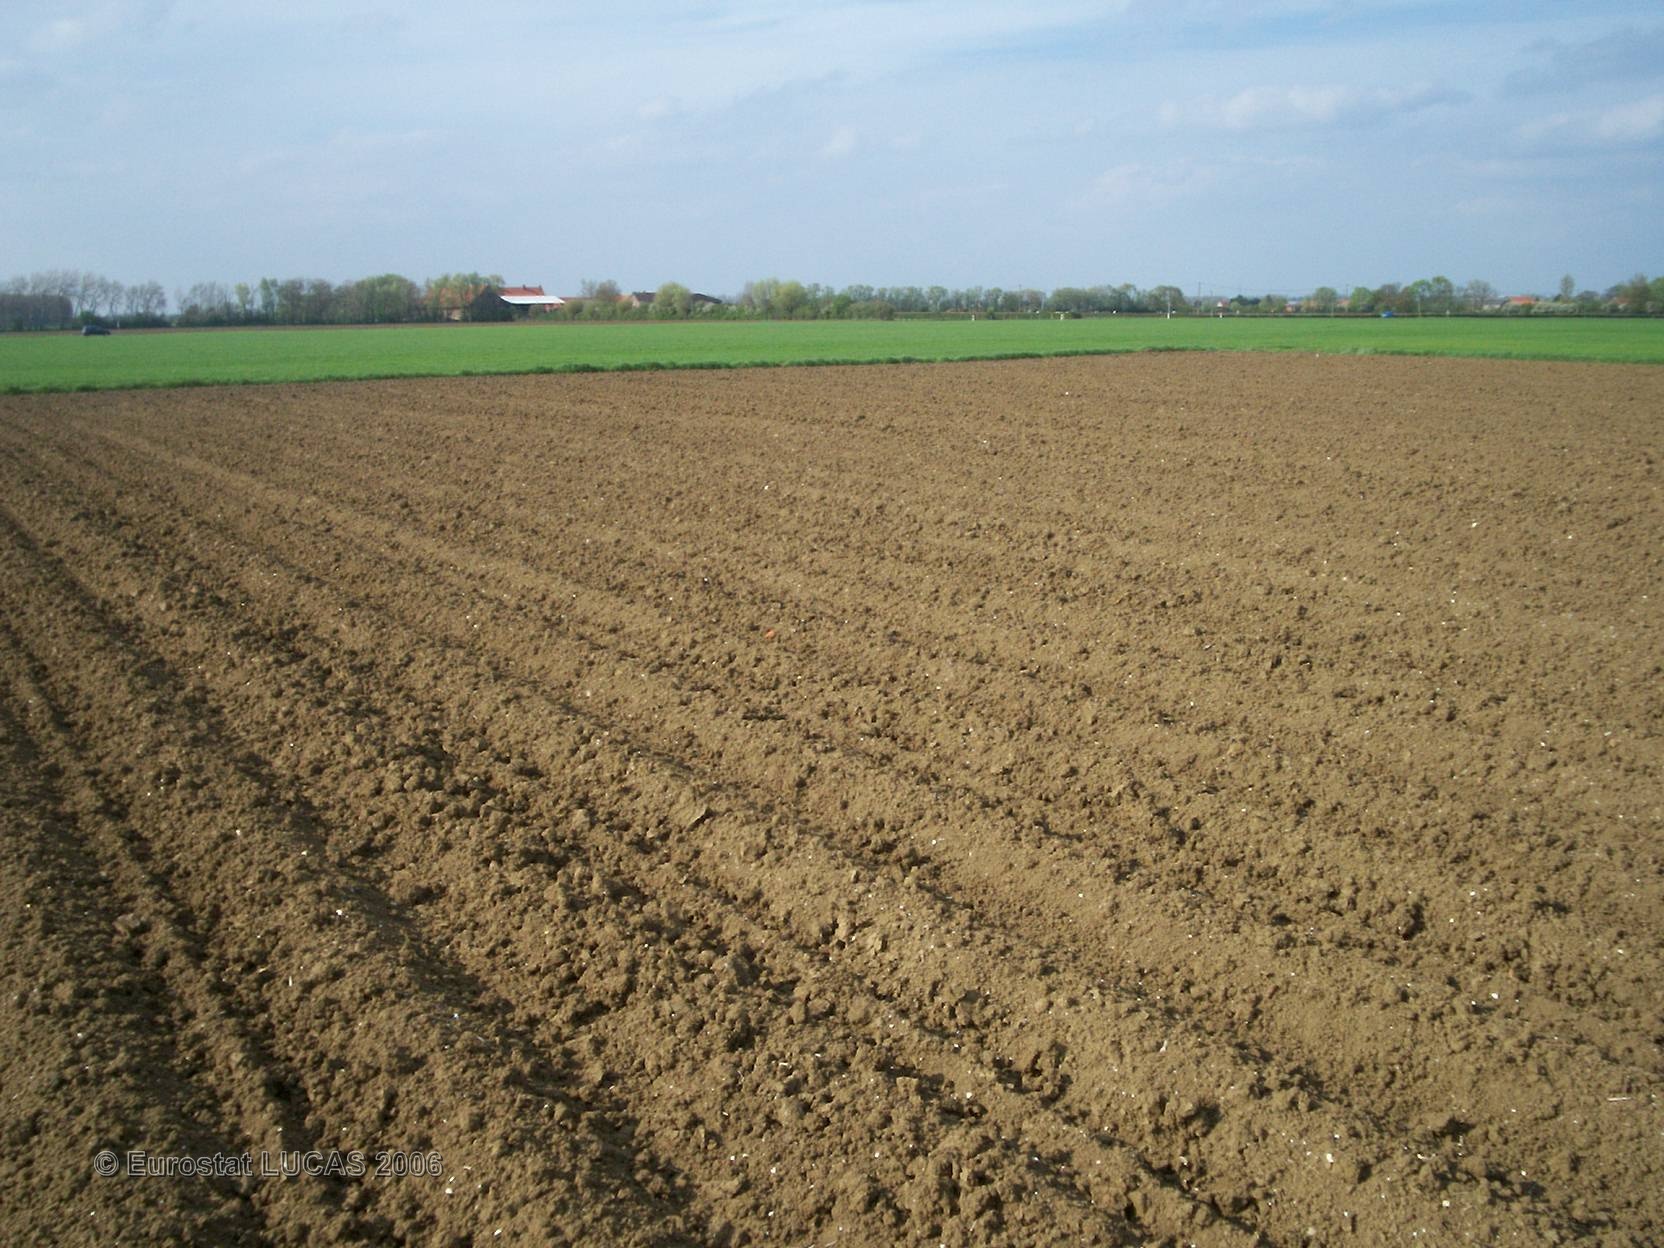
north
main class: Cropland
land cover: Potatoes
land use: Agriculture (excluding fallow land and kitchen gardens)
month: May
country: FR
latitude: 50.7009
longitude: 2.5828
